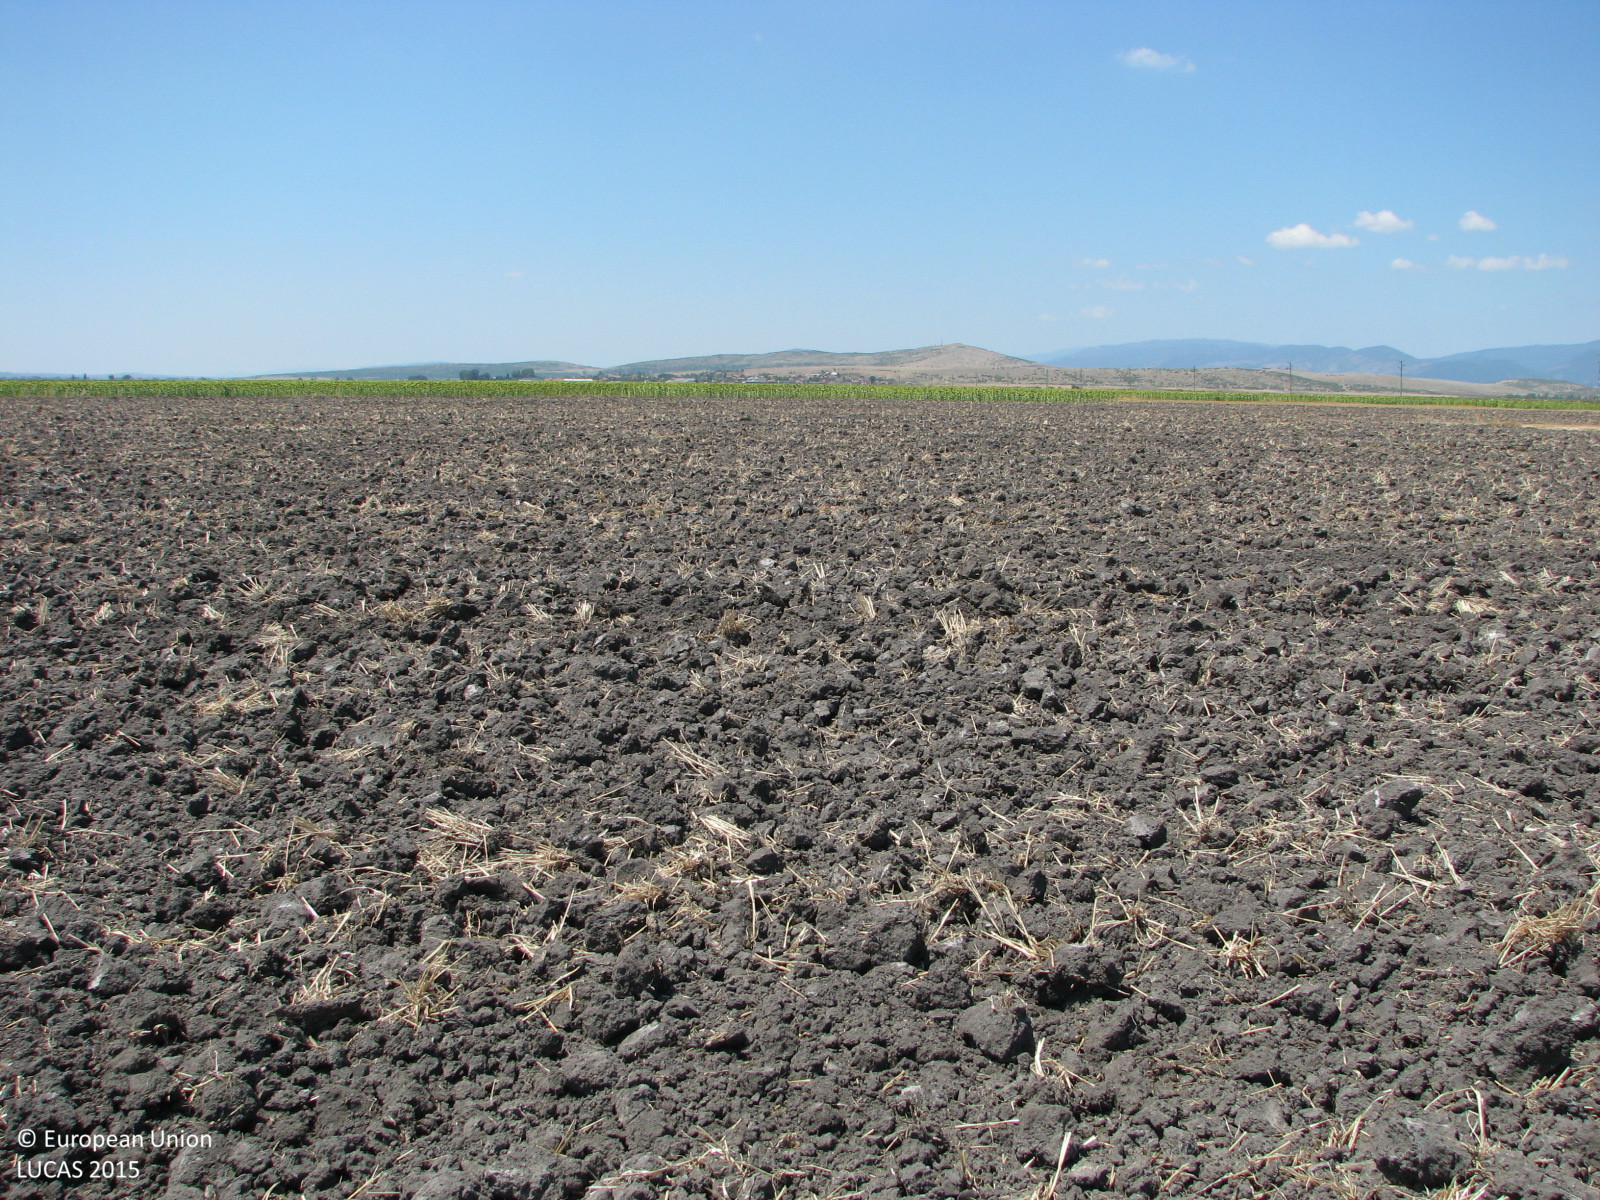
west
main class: Cropland
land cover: Common wheat
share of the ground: < 10 %
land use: Agriculture (excluding fallow land and kitchen gardens)
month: July
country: BG
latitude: 42.6020
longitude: 26.4617
